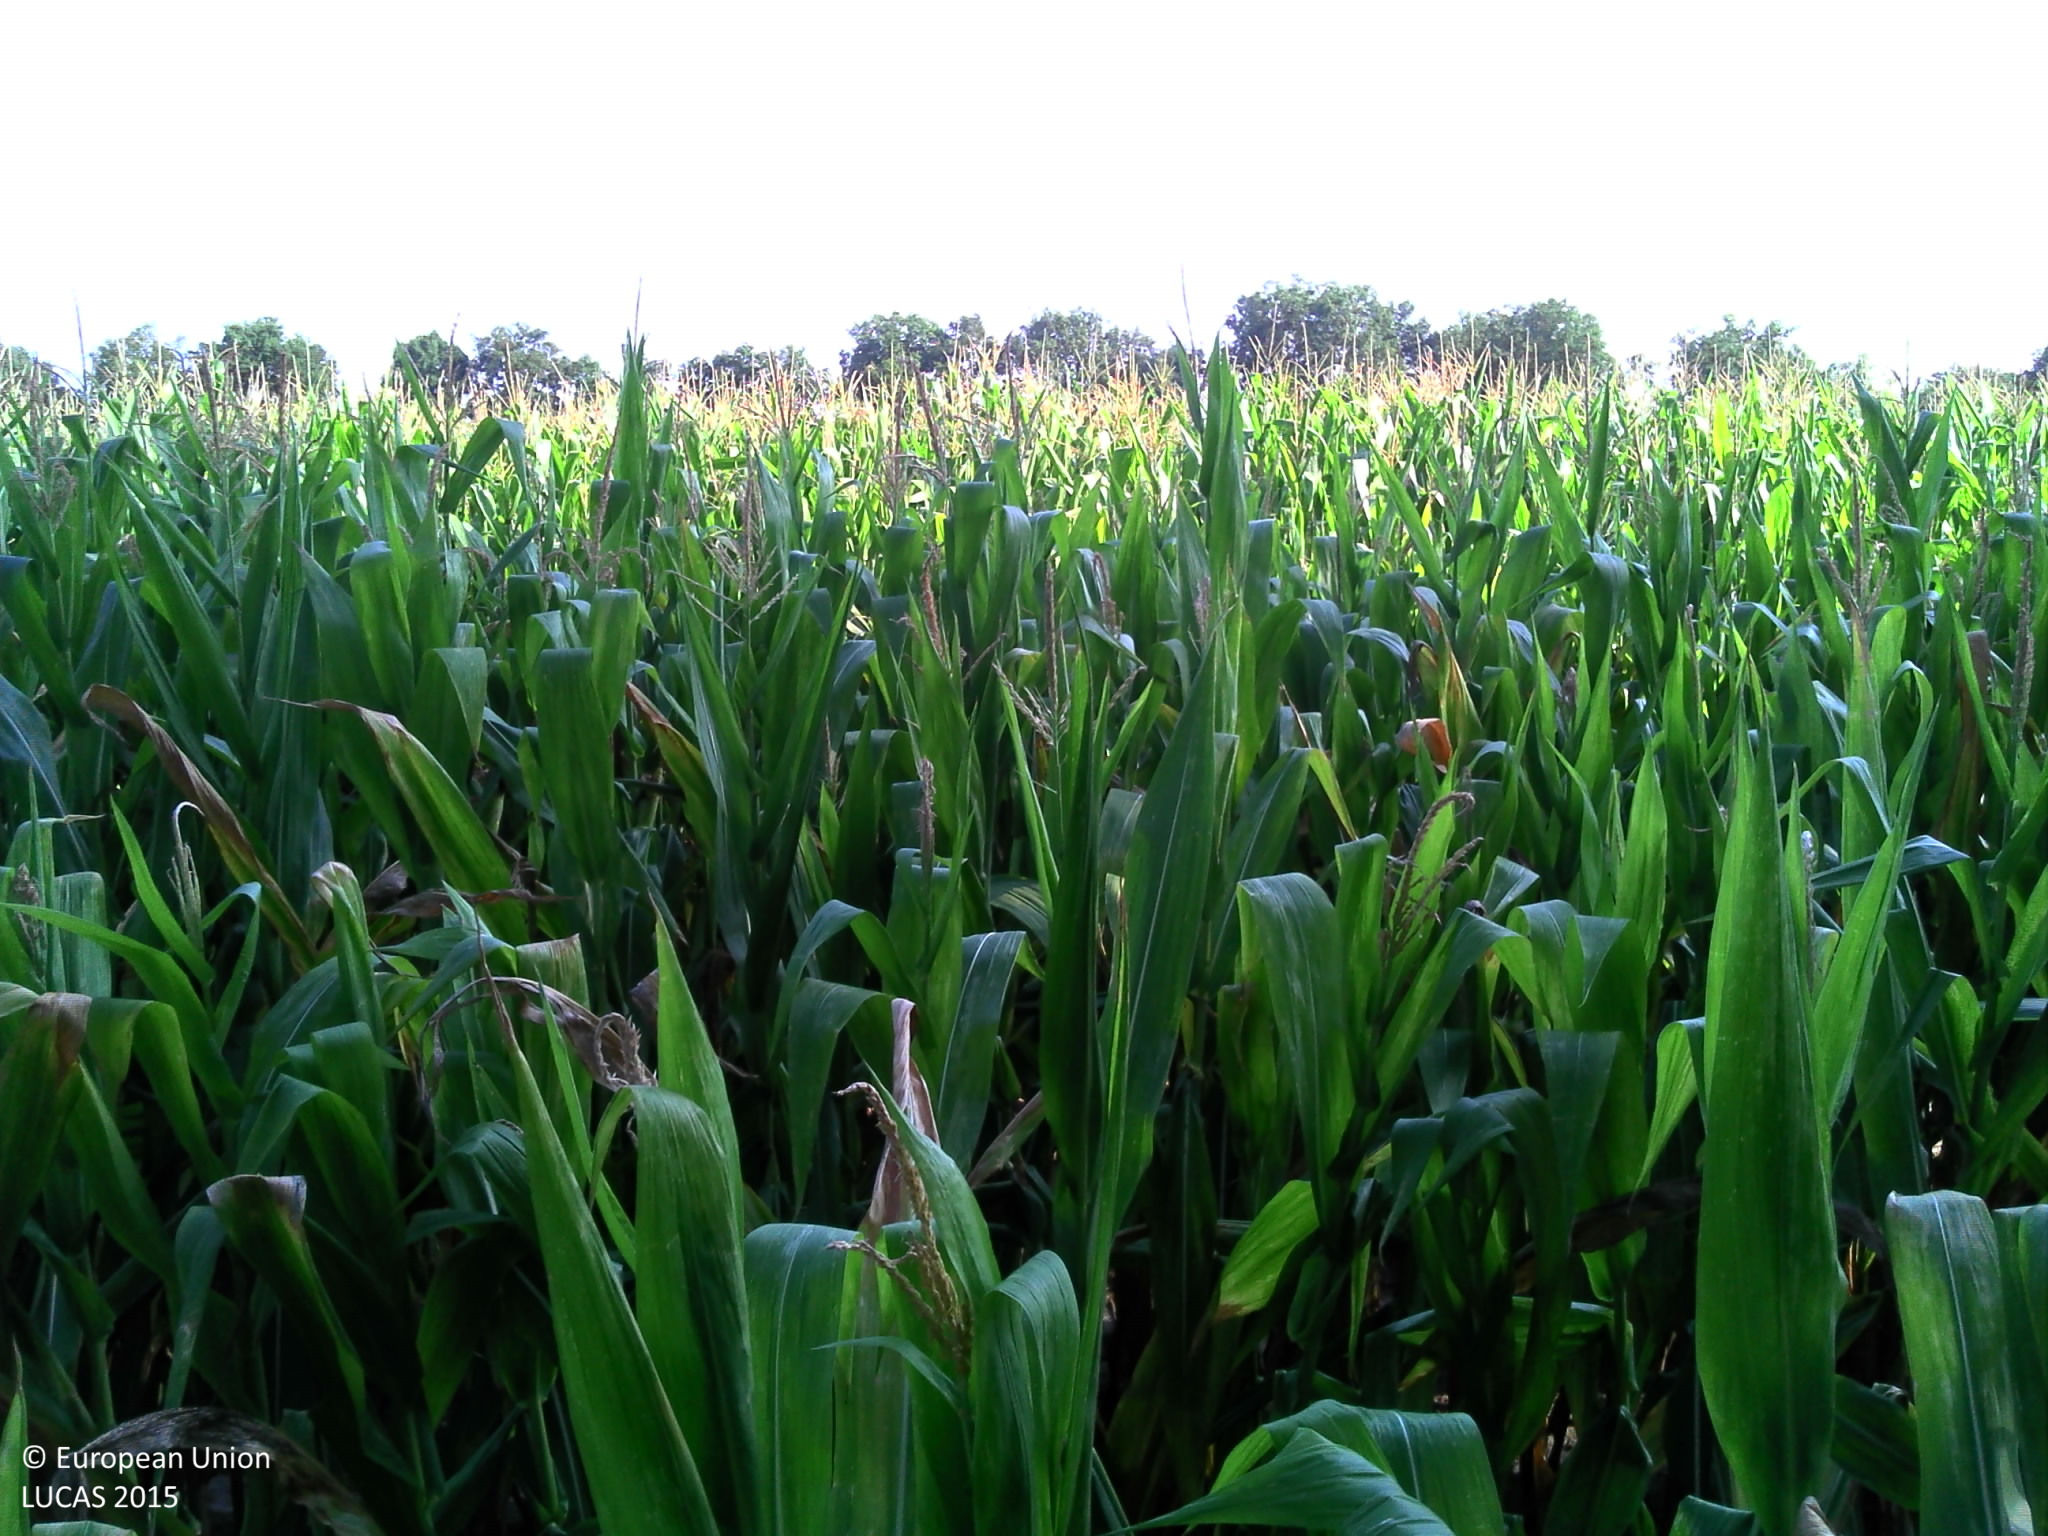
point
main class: Cropland
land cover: Maize
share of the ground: > 75 %
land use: Agriculture (excluding fallow land and kitchen gardens)
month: August
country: FR
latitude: 45.6666
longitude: 4.1369
